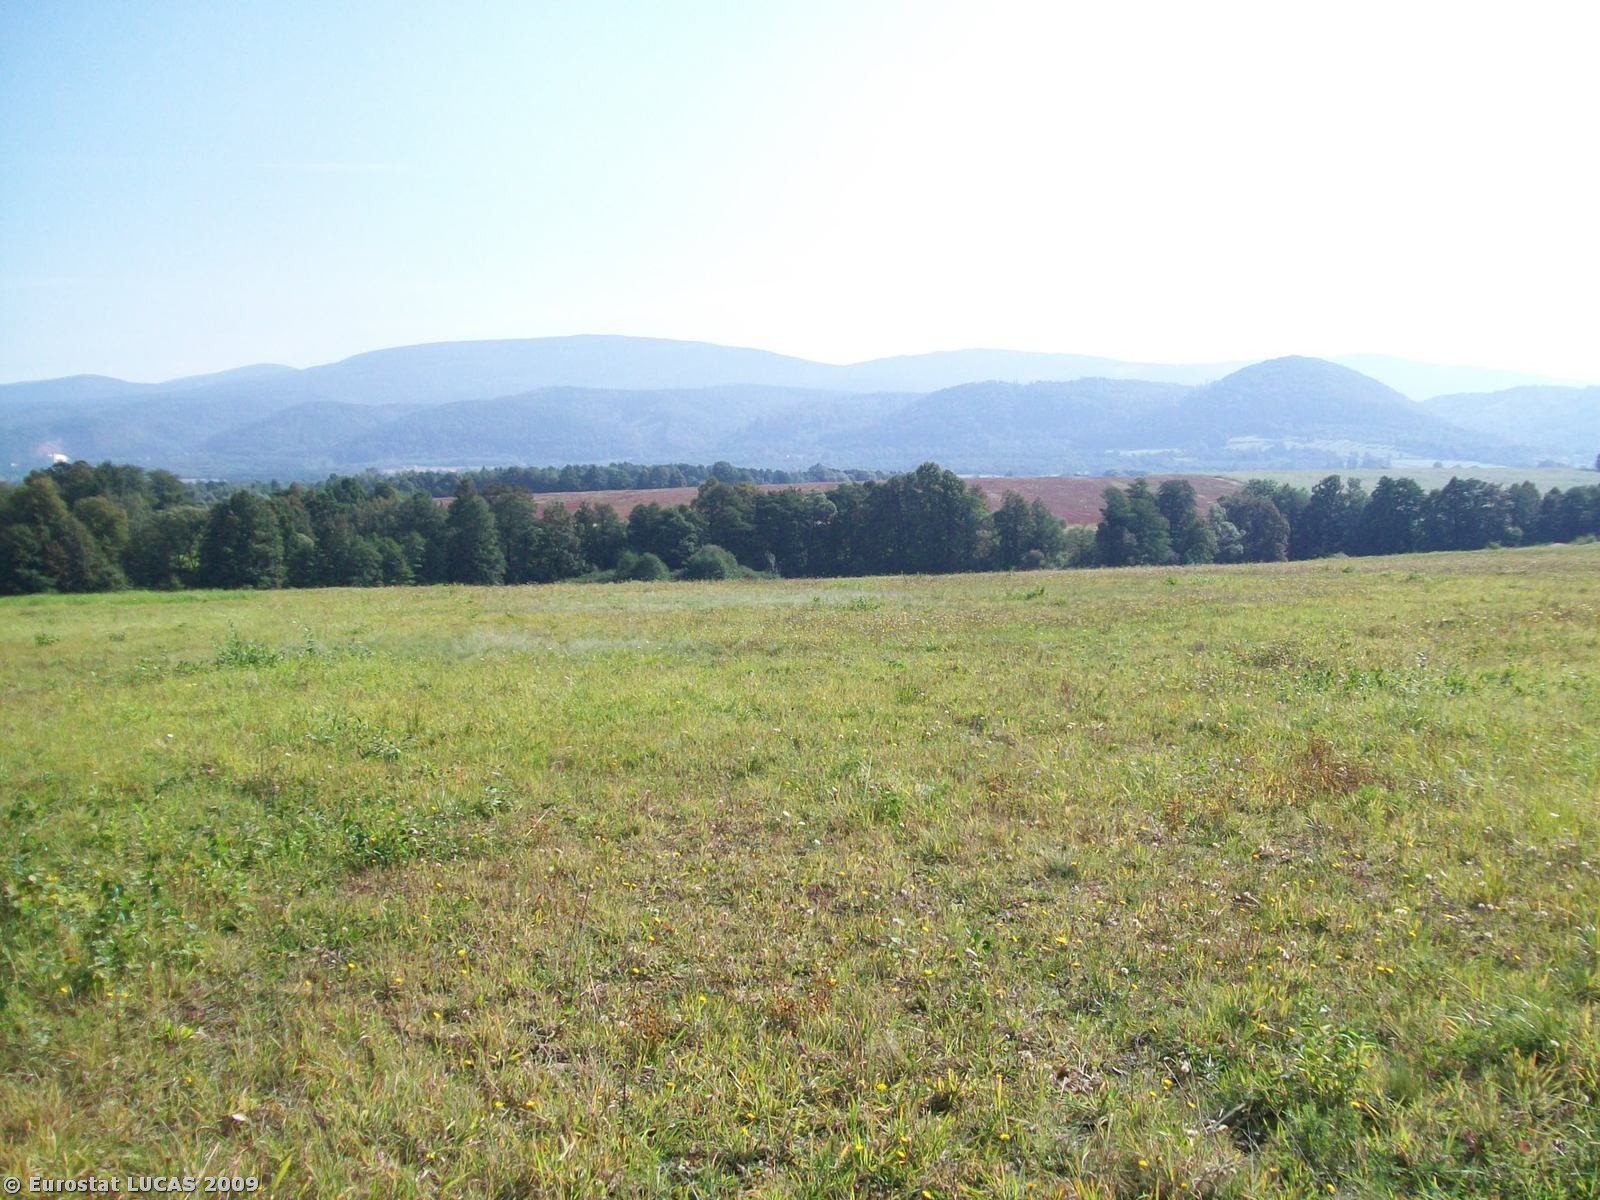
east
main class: Grassland
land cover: Grassland without tree/shrub cover
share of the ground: > 75 %
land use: Agriculture (excluding fallow land and kitchen gardens)
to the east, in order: Grassland without tree/shrub cover
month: September
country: PL
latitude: 50.1863
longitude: 16.6890
